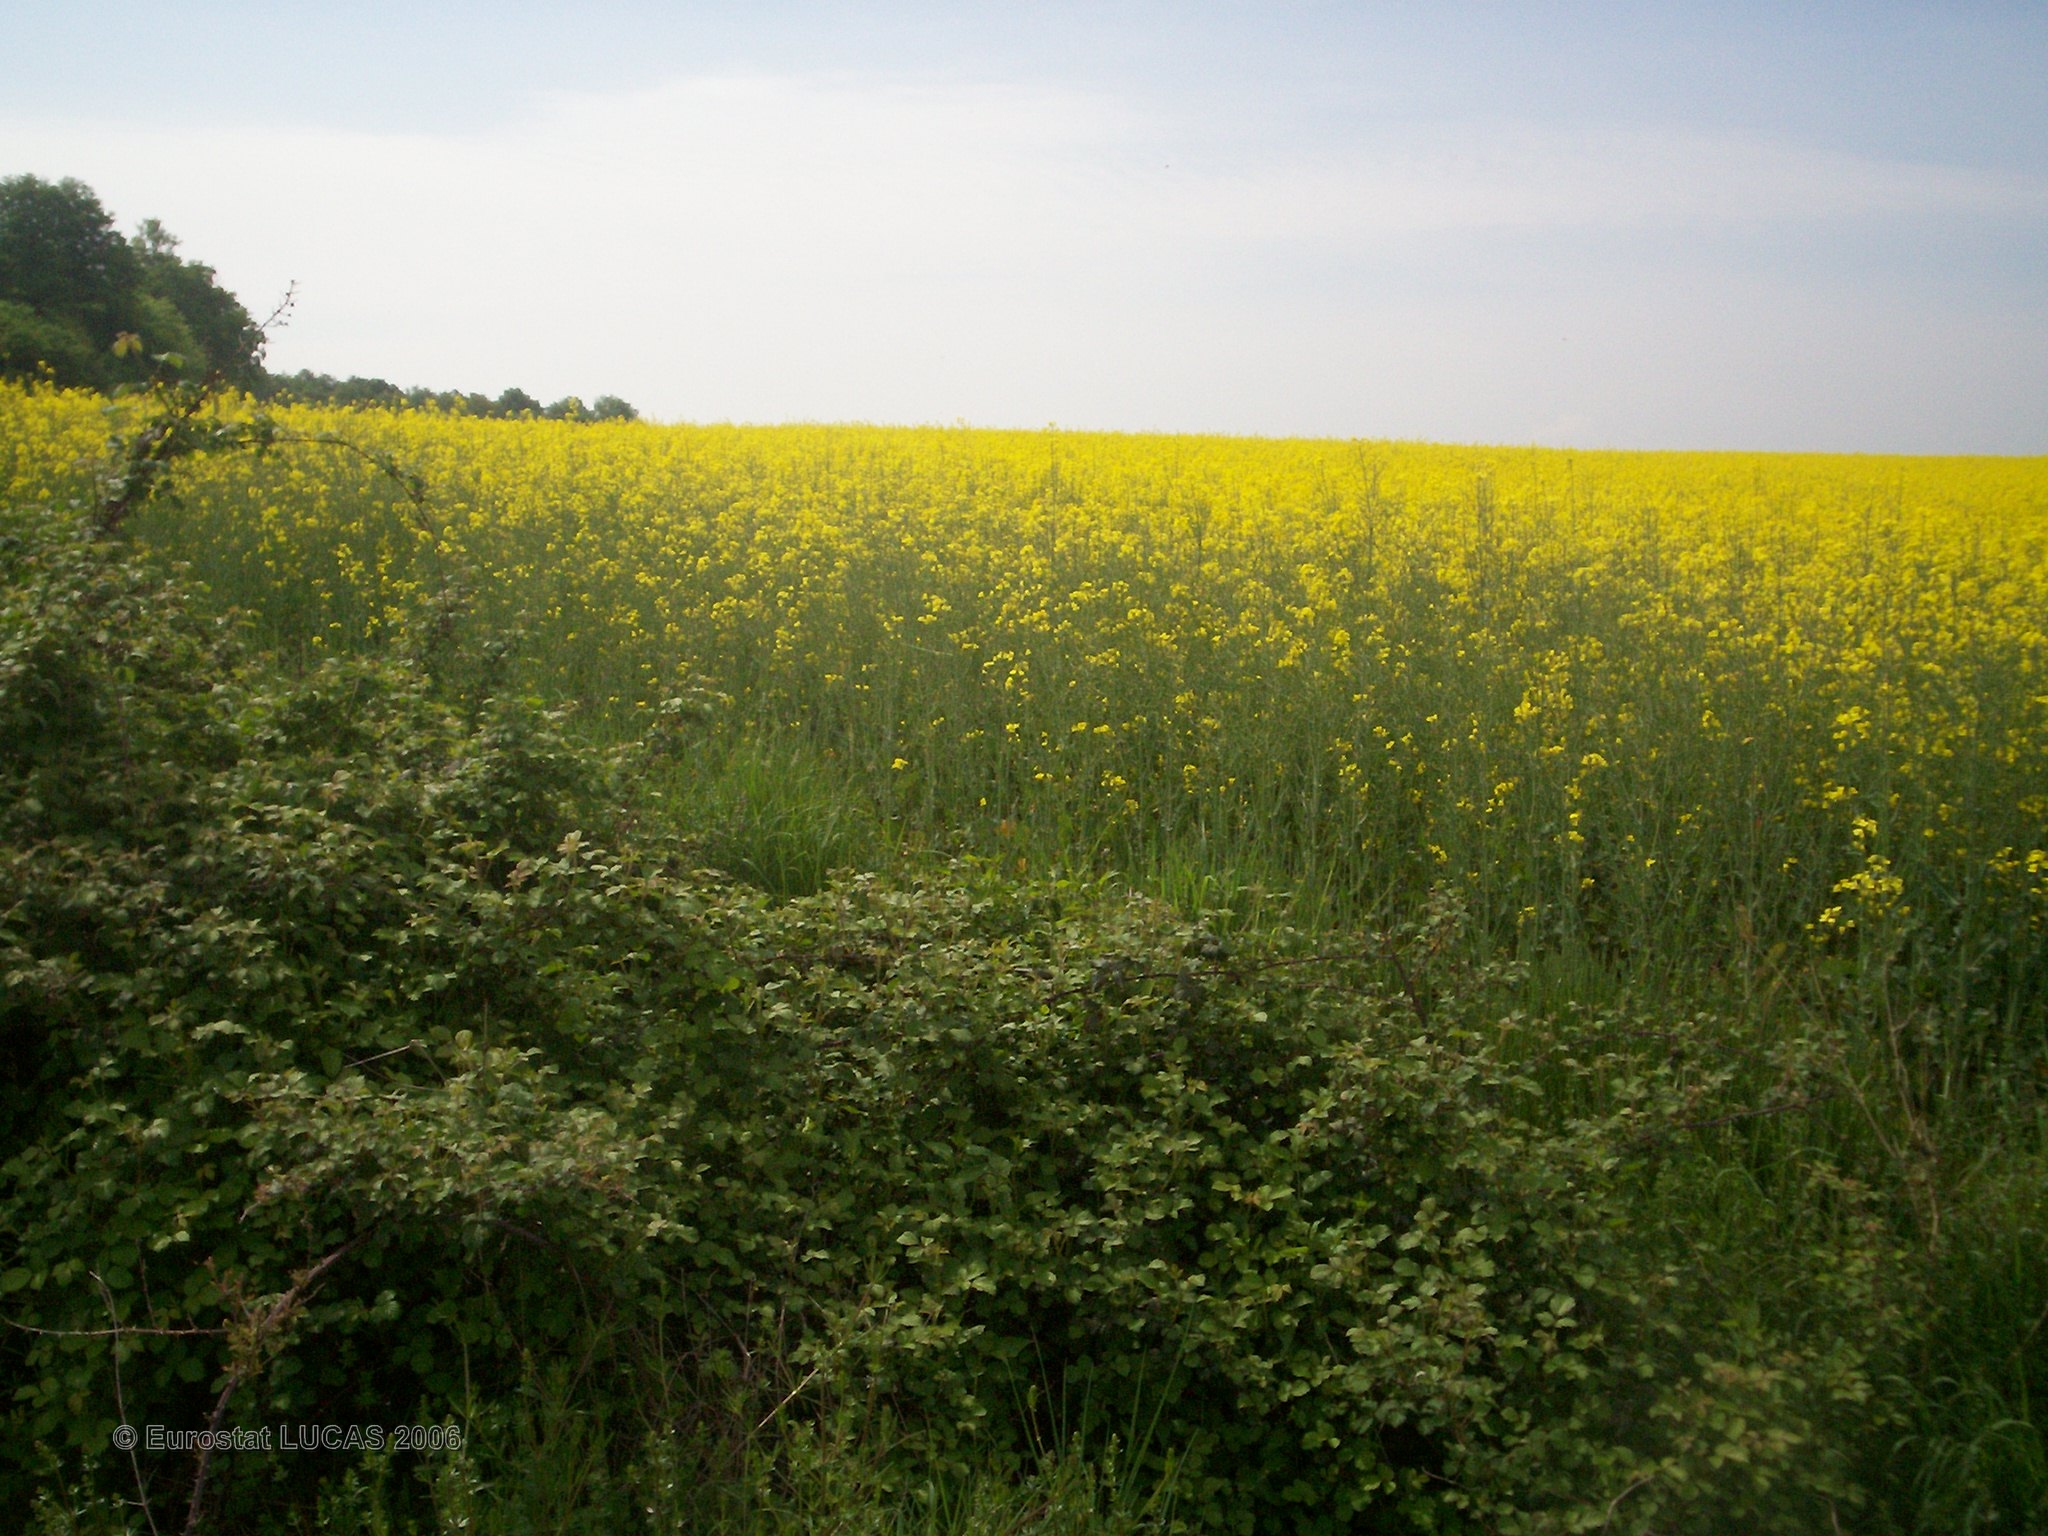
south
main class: Cropland
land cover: Common wheat
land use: Agriculture (excluding fallow land and kitchen gardens)
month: May
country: FR
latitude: 47.7279
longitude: 2.9671
